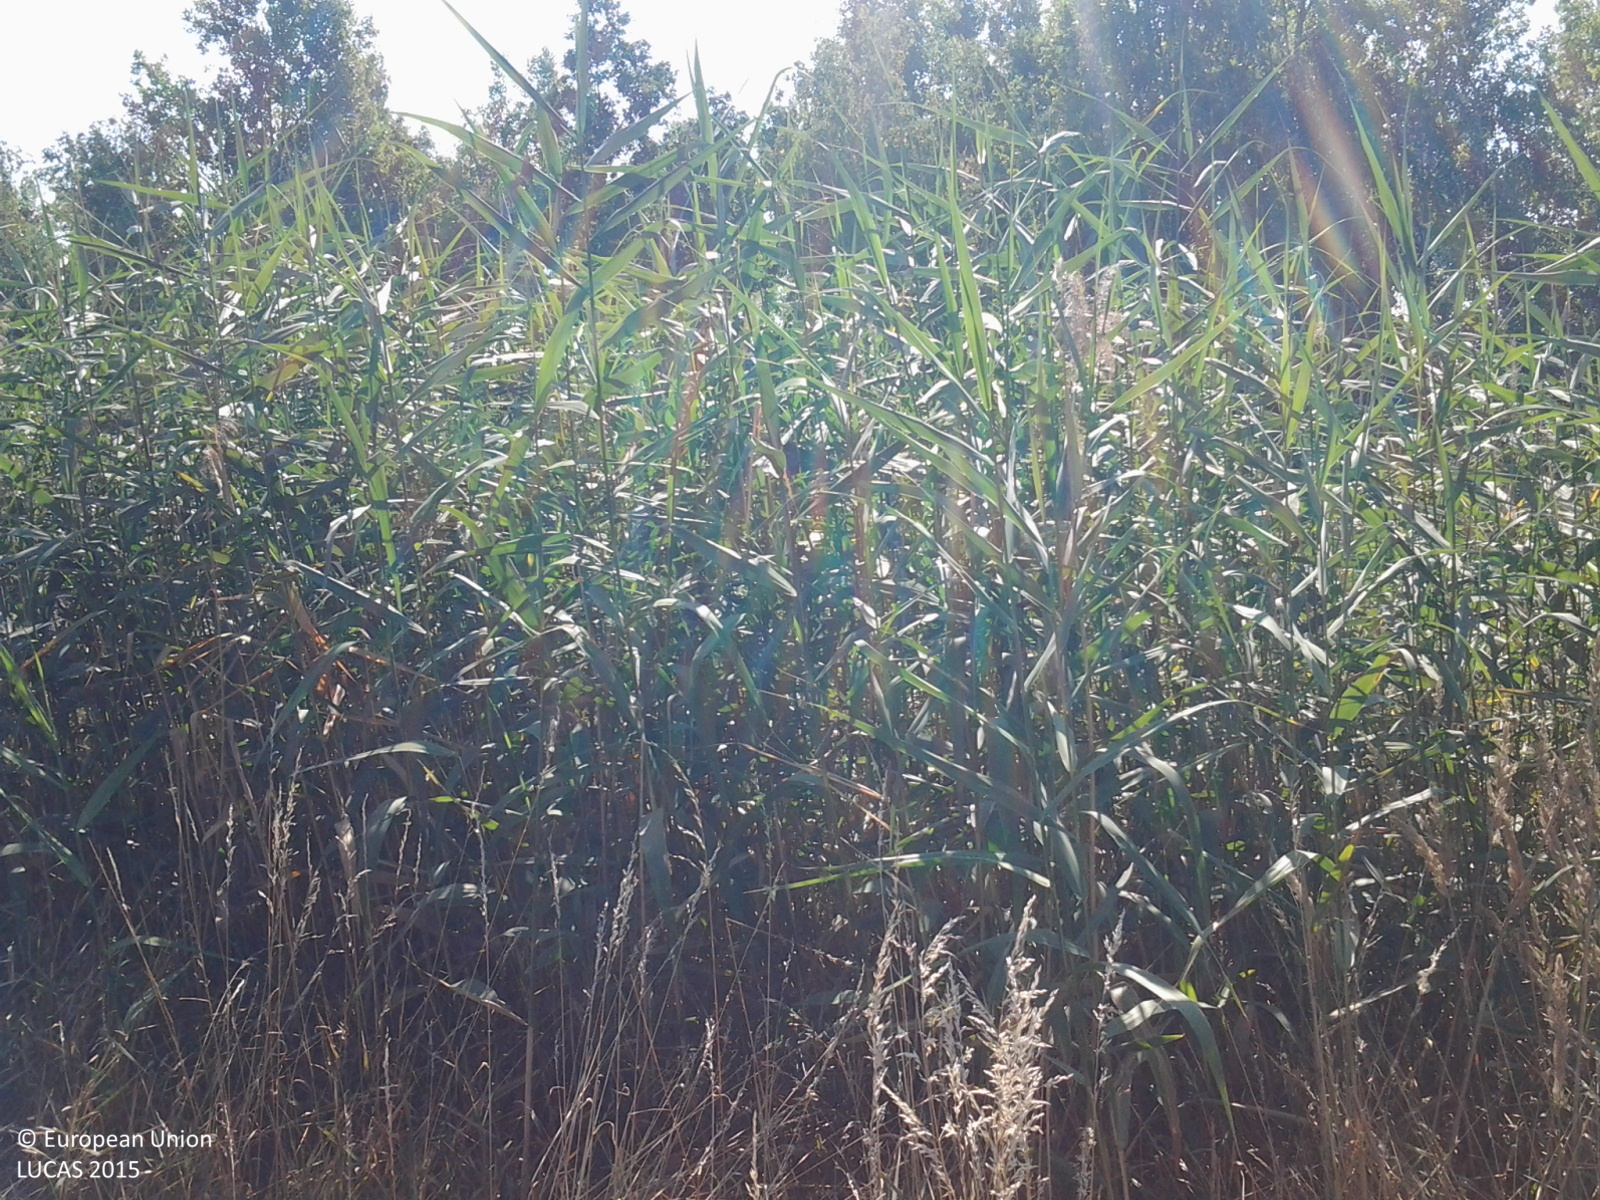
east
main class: Woodland
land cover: Broadleaved woodland
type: mire and swamp forests
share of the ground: 25 - 50 %
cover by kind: herbaceous plants 70 %, broadleaved forest trees 30 %
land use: Abandoned areas
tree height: < 5 m
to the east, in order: Broadleaved woodland; Inland fresh running water; Inland marshes; Broadleaved woodland; Inland marshes; Inland fresh running water; Inland marshes; Abandoned hedges; Grassland without tree/shrub cover
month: July
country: HU
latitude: 47.3676
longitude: 20.5853
